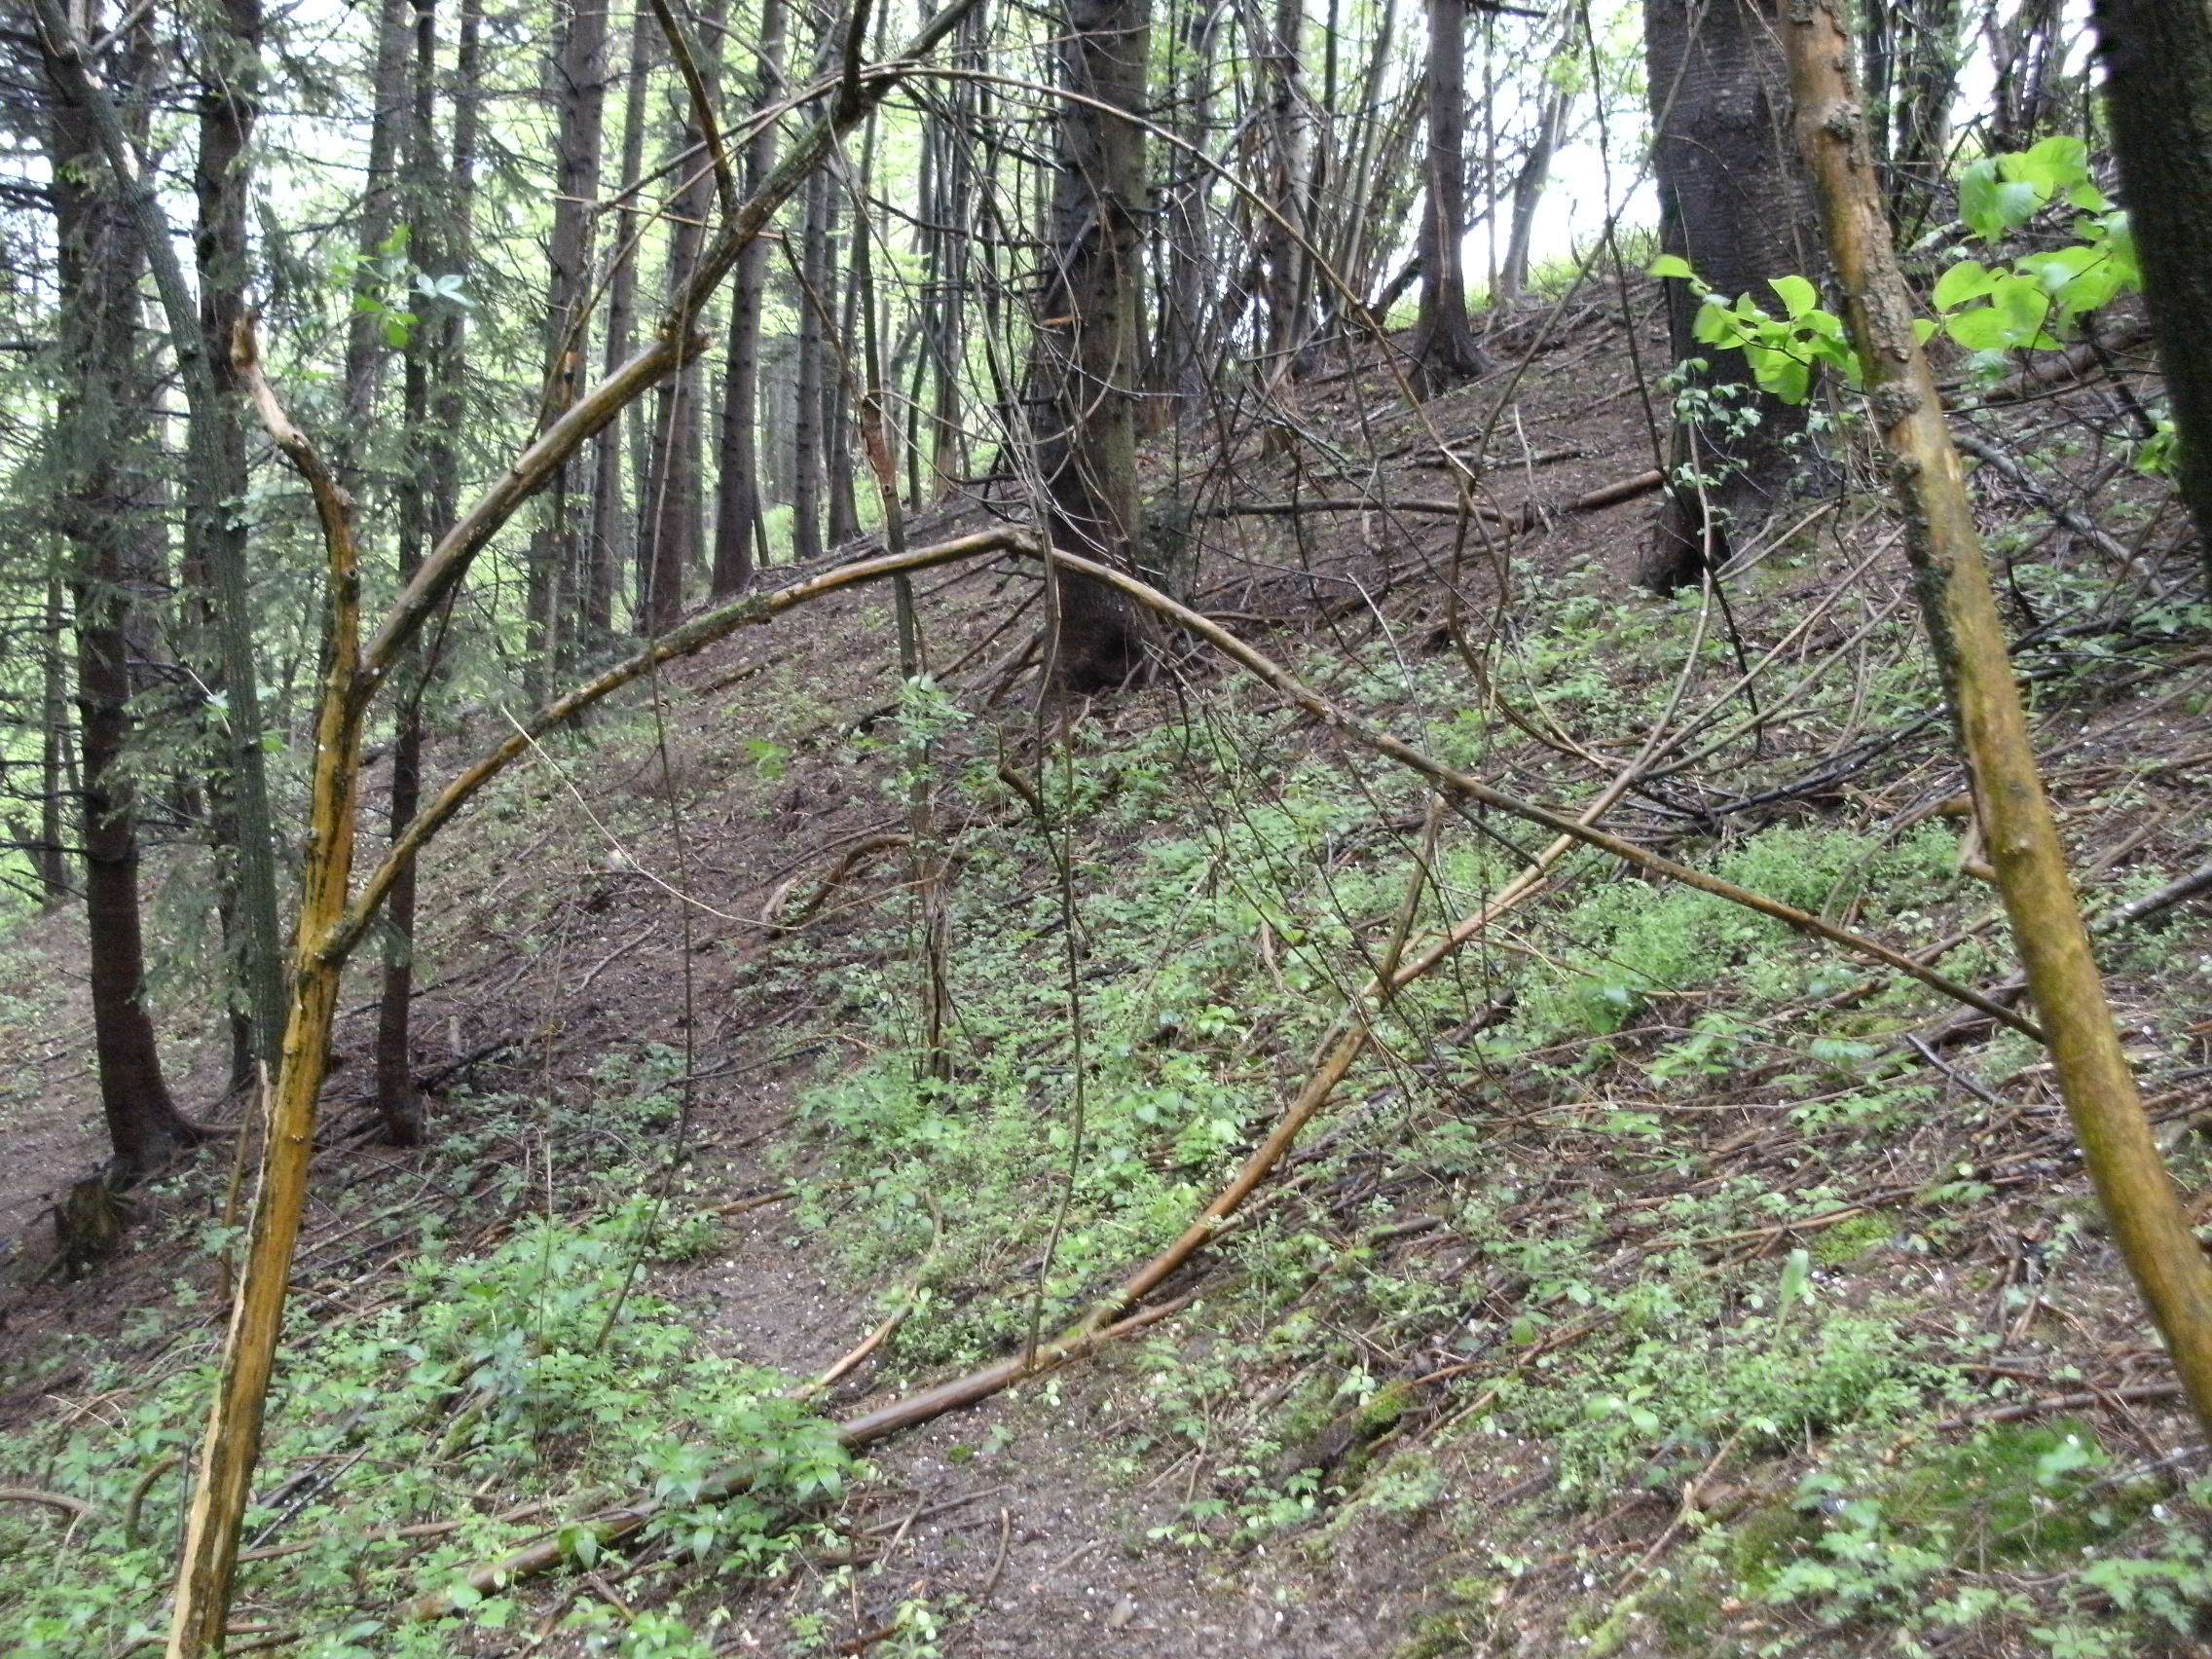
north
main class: Woodland
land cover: Broadleaved woodland
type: mesophytic deciduous forest
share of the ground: > 75 %
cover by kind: broadleaved forest trees 50 %, herbaceous plants 25 %, shrubs 20 %, coniferous forest trees 5 %
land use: Forestry
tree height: > 5 m
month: May
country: AT
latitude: 48.1857
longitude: 13.5099
